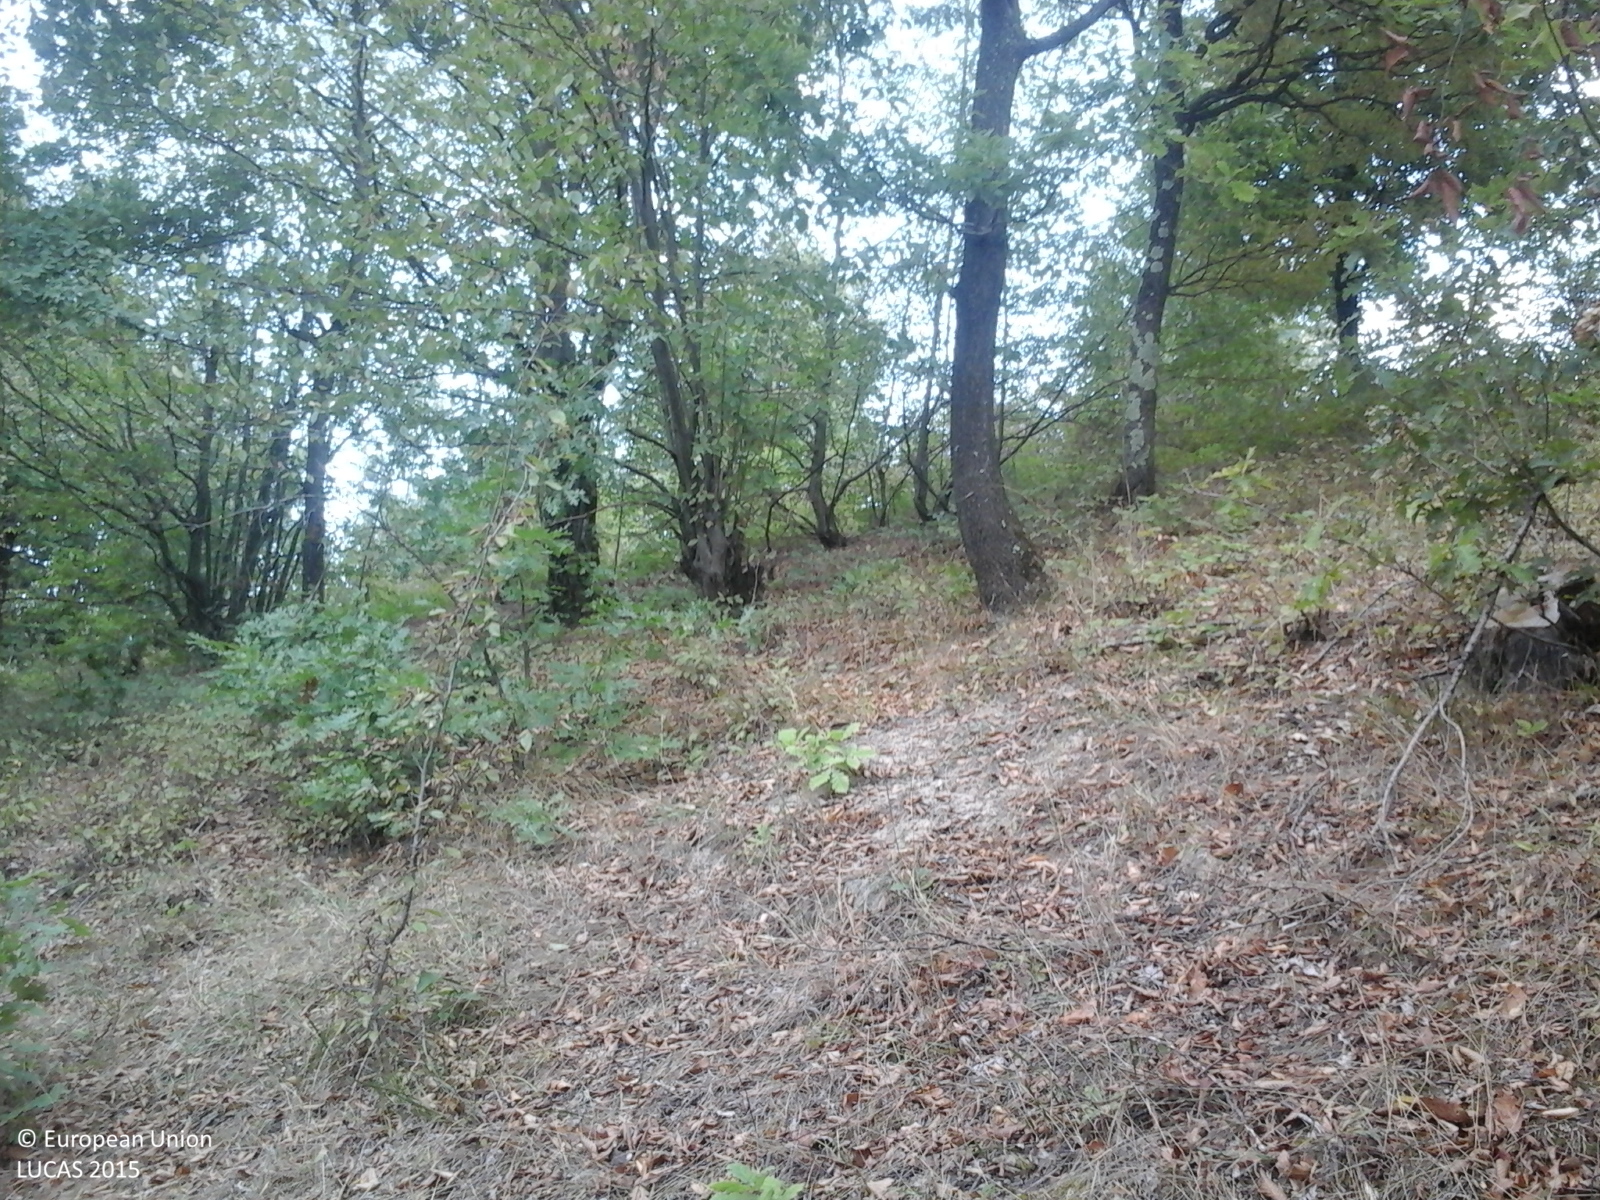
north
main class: Woodland
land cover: Broadleaved woodland
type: acidophilous oak and oak-birch forest
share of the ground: > 75 %
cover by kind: broadleaved forest trees 100 %
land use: Forestry
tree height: > 5 m
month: September
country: RO
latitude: 45.3873
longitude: 22.1090
